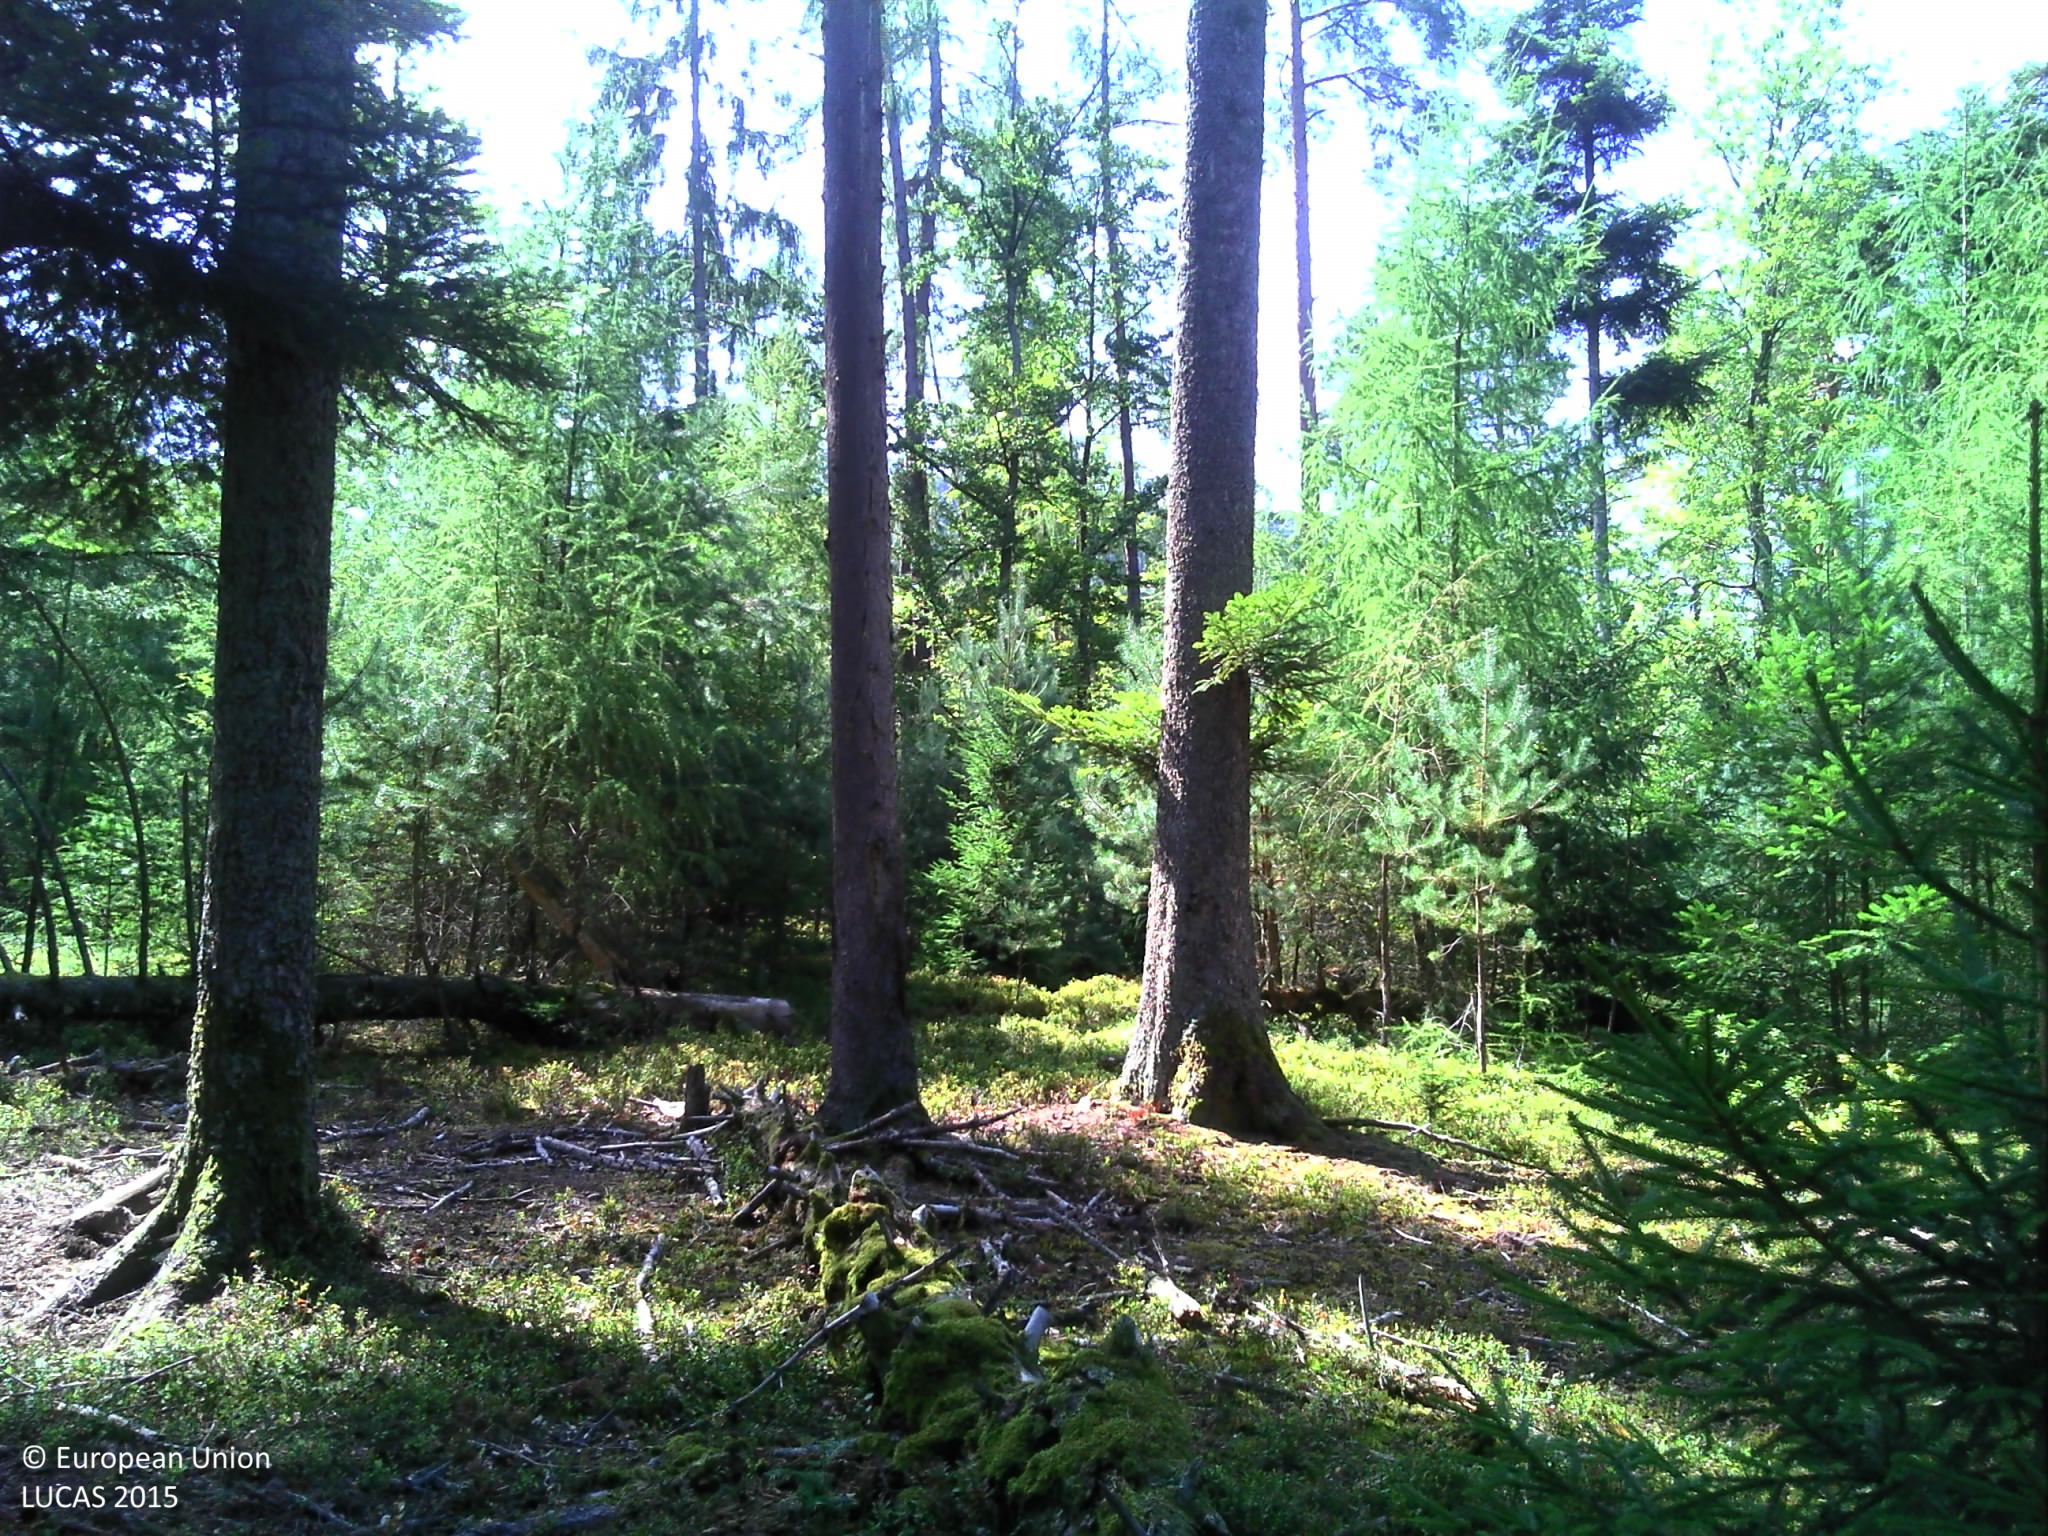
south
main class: Woodland
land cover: Spruce dominated mixed woodland
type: hemiboreal forest and nemoral coniferous forest and mixed broadleaved-coniferous forest
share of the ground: > 75 %
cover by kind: coniferous forest trees 60 %, broadleaved forest trees 30 %, herbaceous plants 10 %
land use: Forestry
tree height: > 5 m
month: August
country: FR
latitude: 48.2637
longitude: 7.3472
